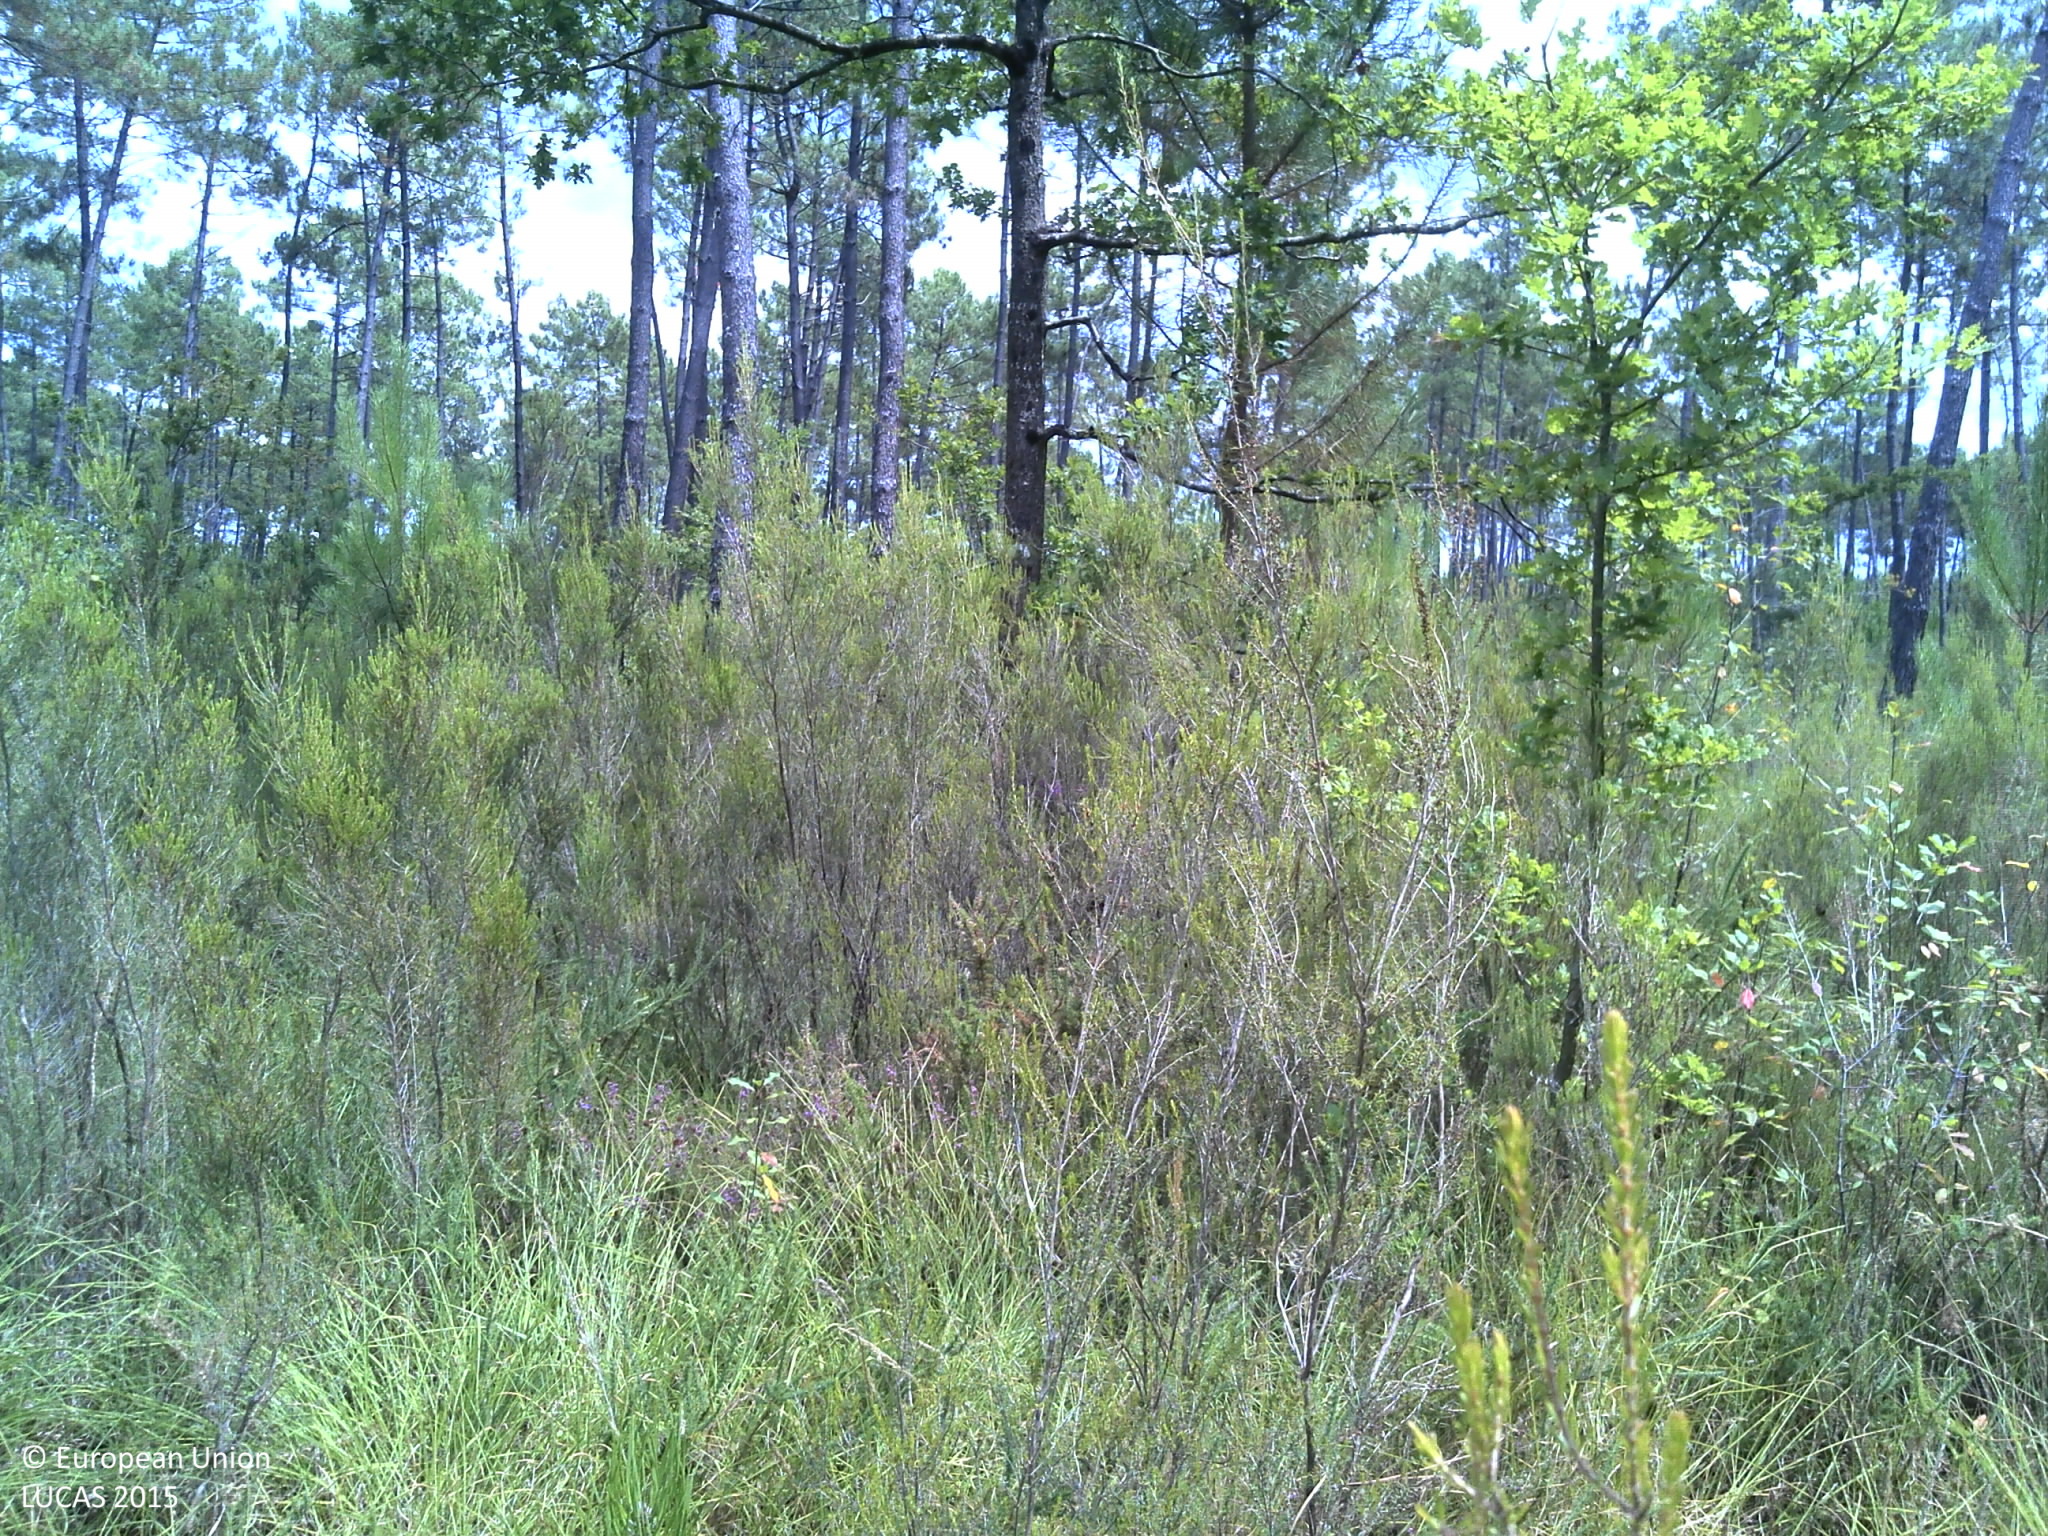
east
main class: Woodland
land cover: Pine dominated coniferous woodland
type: coniferous forest of the mediterranean region
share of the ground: > 75 %
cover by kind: coniferous forest trees 60 %, shrubs 25 %, broadleaved forest trees 10 %, herbaceous plants 5 %
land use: Forestry
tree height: < 5 m
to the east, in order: Pine dominated coniferous woodland; Tracks; Pine dominated coniferous woodland
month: August
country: FR
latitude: 44.8584
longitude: -0.9688
